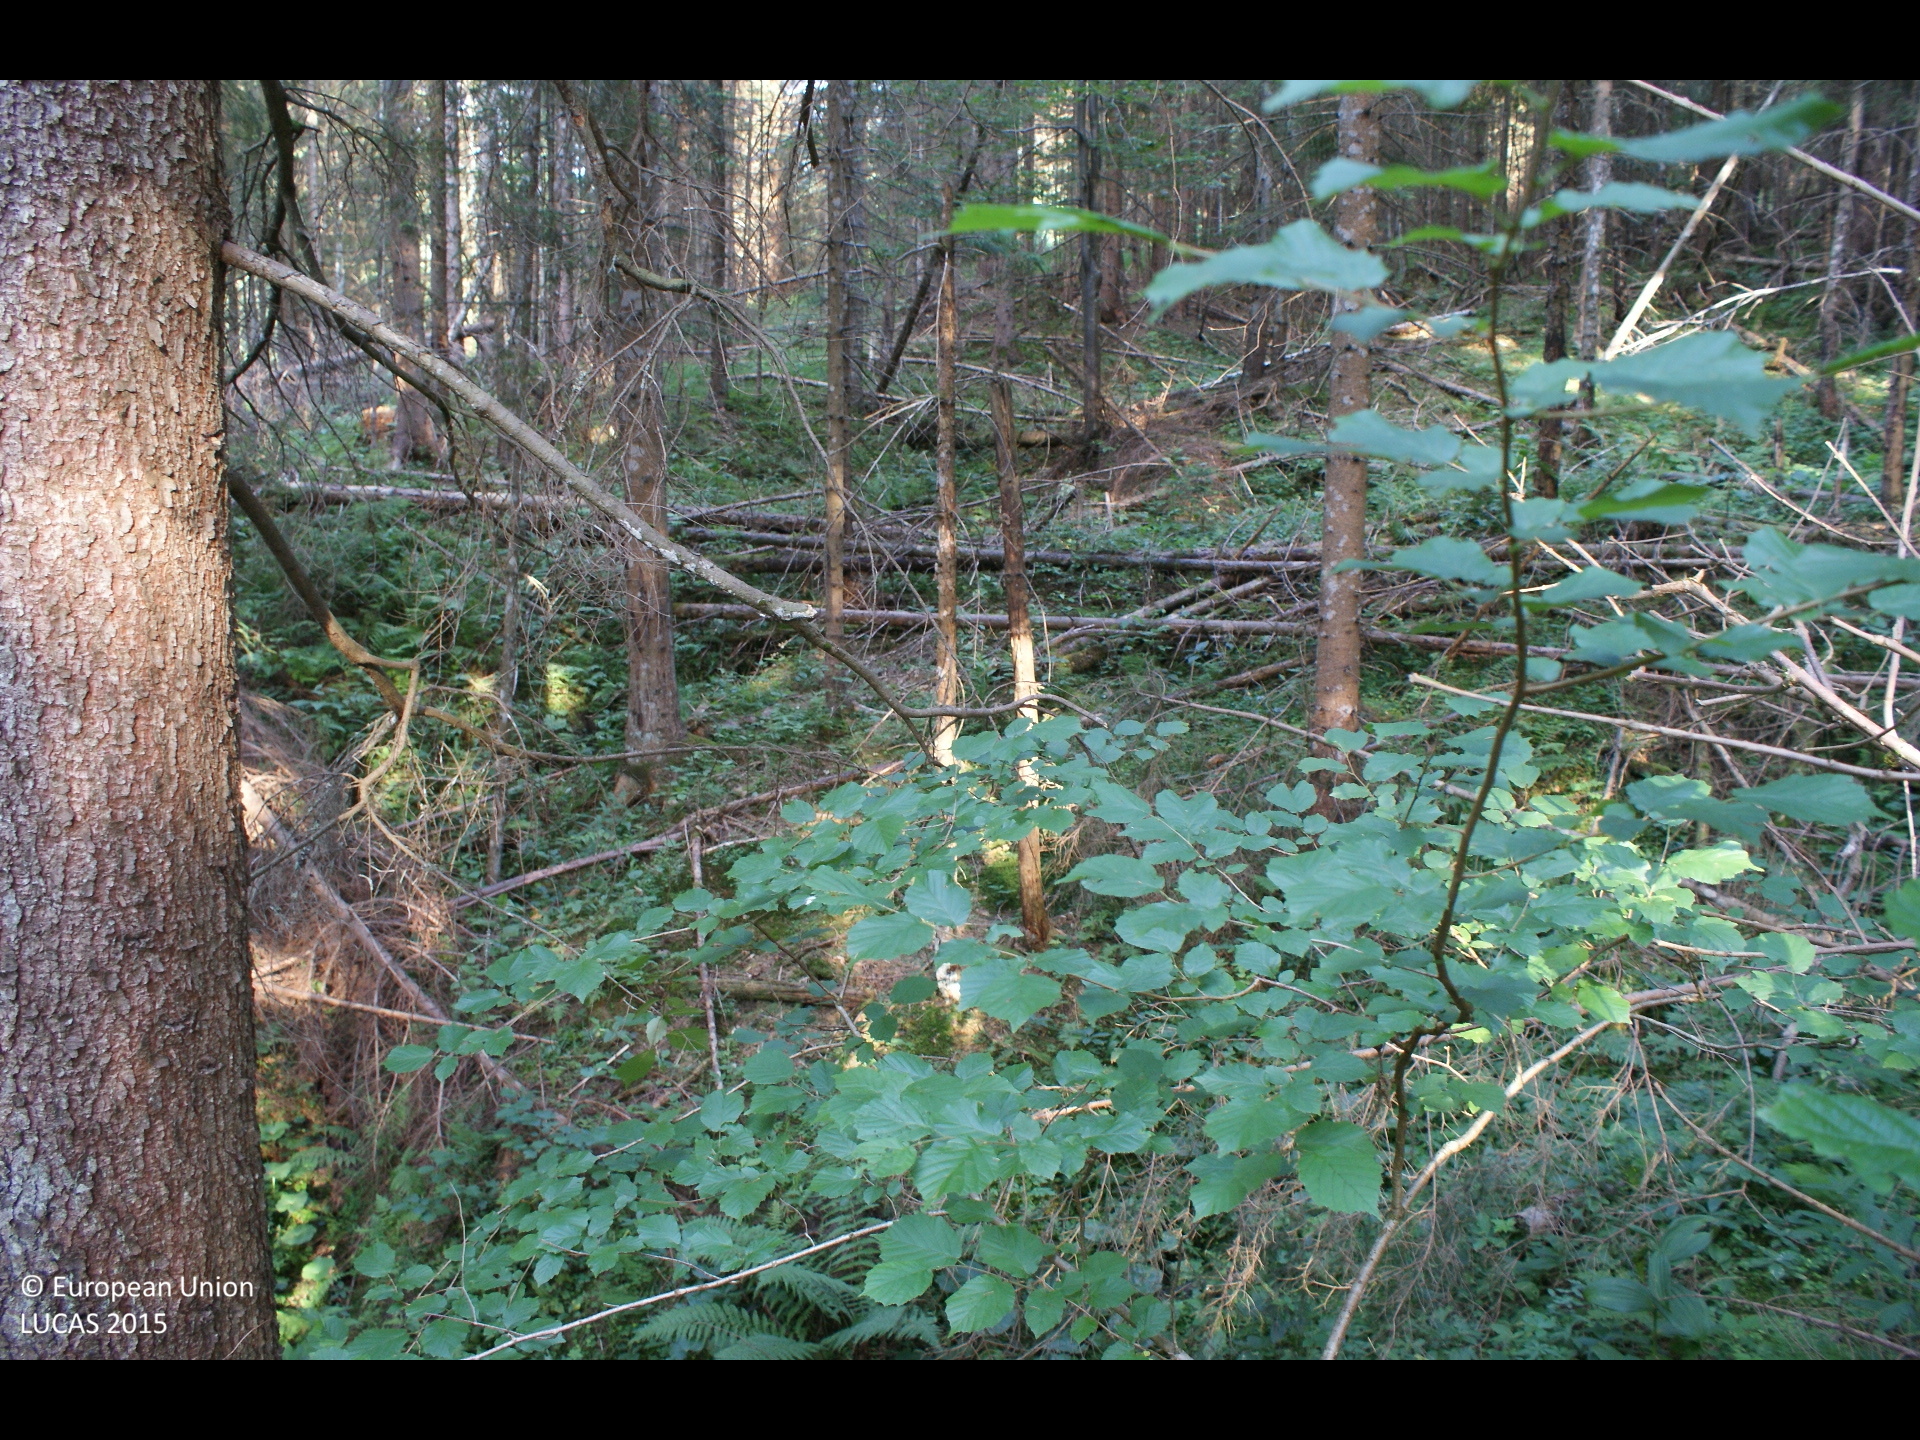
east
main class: Woodland
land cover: Spruce dominated mixed woodland
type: mesophytic deciduous forest
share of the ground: > 75 %
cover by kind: coniferous forest trees 65 %, broadleaved forest trees 25 %, herbaceous plants 10 %
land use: Forestry
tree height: > 5 m
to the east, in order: Spruce dominated mixed woodland; Spruce dominated coniferous woodland; Other mixed woodland; Grassland without tree/shrub cover; Spruce dominated mixed woodland; Rivers and streams; Spruce dominated mixed woodland; Spruce dominated coniferous woodland; Tracks; Spruce dominated mixed woodland; Rivers and streams; Spruce dominated coniferous woodland; Rivers and streams; Spruce dominated mixed woodland
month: July
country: AT
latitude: 47.7650
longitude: 15.4316
